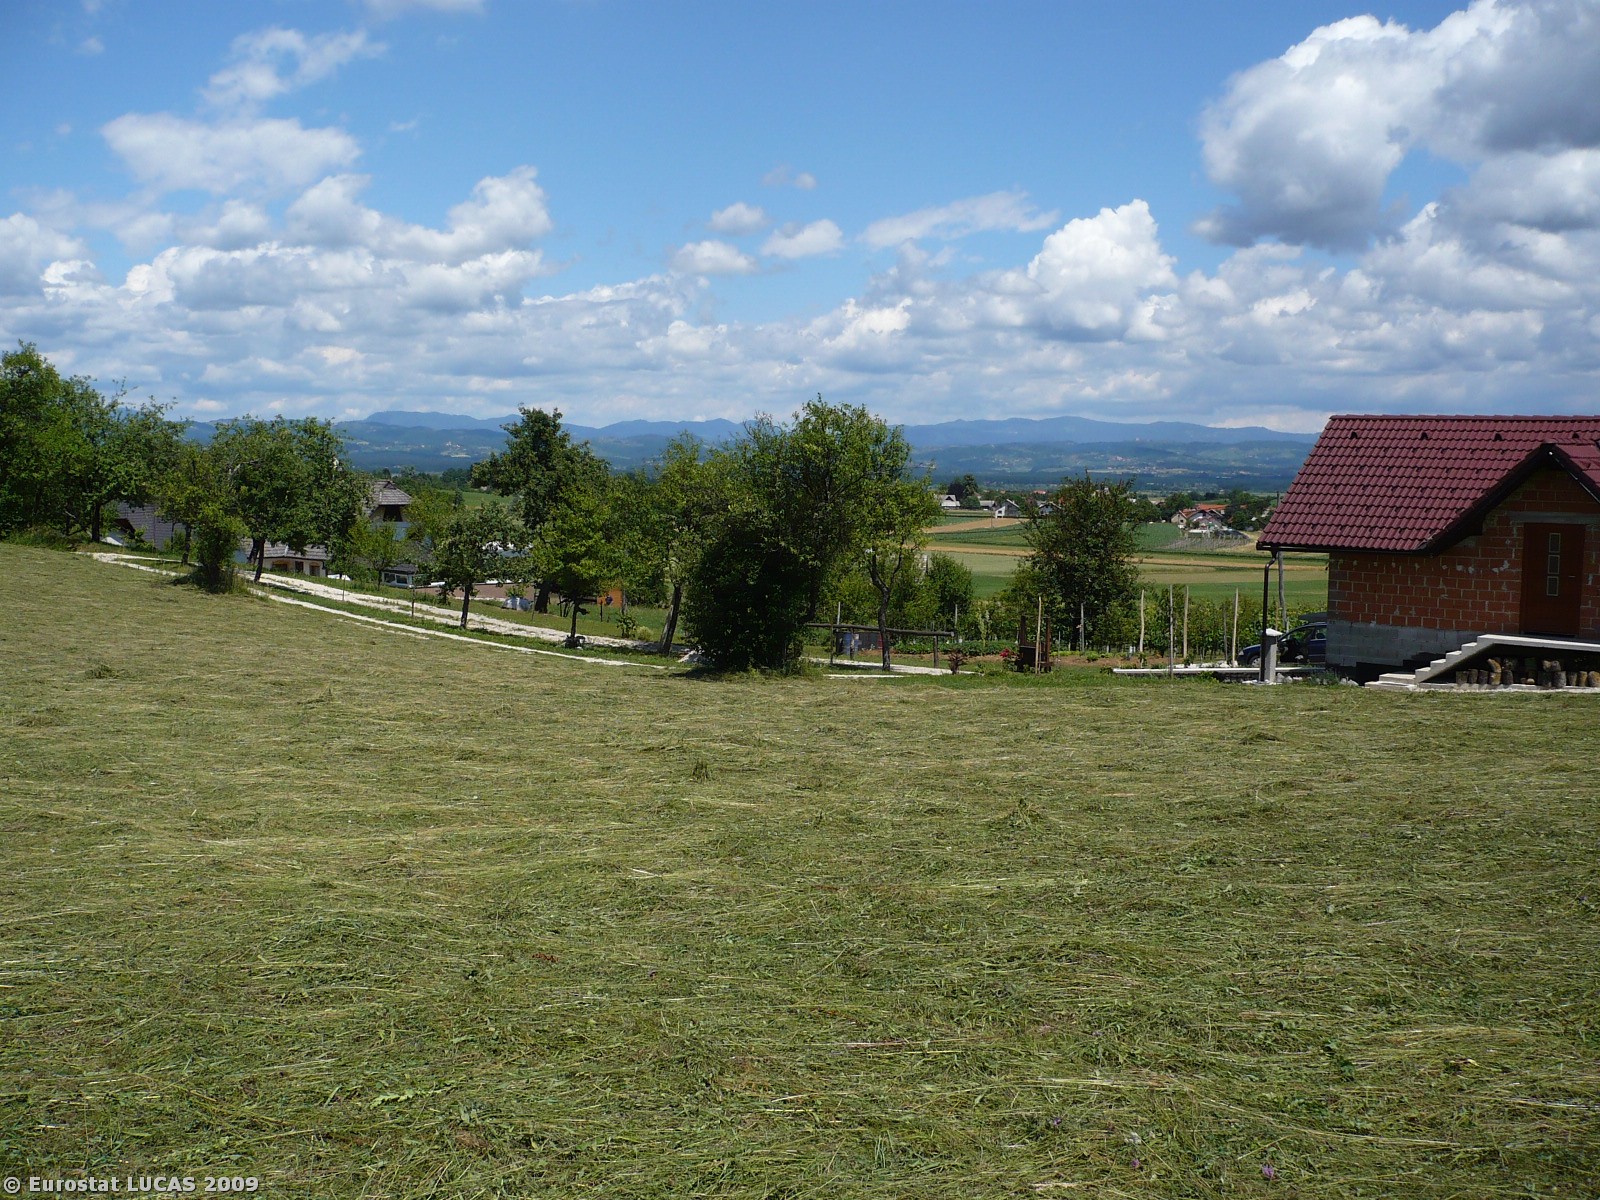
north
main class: Grassland
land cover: Grassland without tree/shrub cover
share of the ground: > 75 %
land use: Agriculture (excluding fallow land and kitchen gardens)
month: June
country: SI
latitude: 45.8208
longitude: 15.3383
